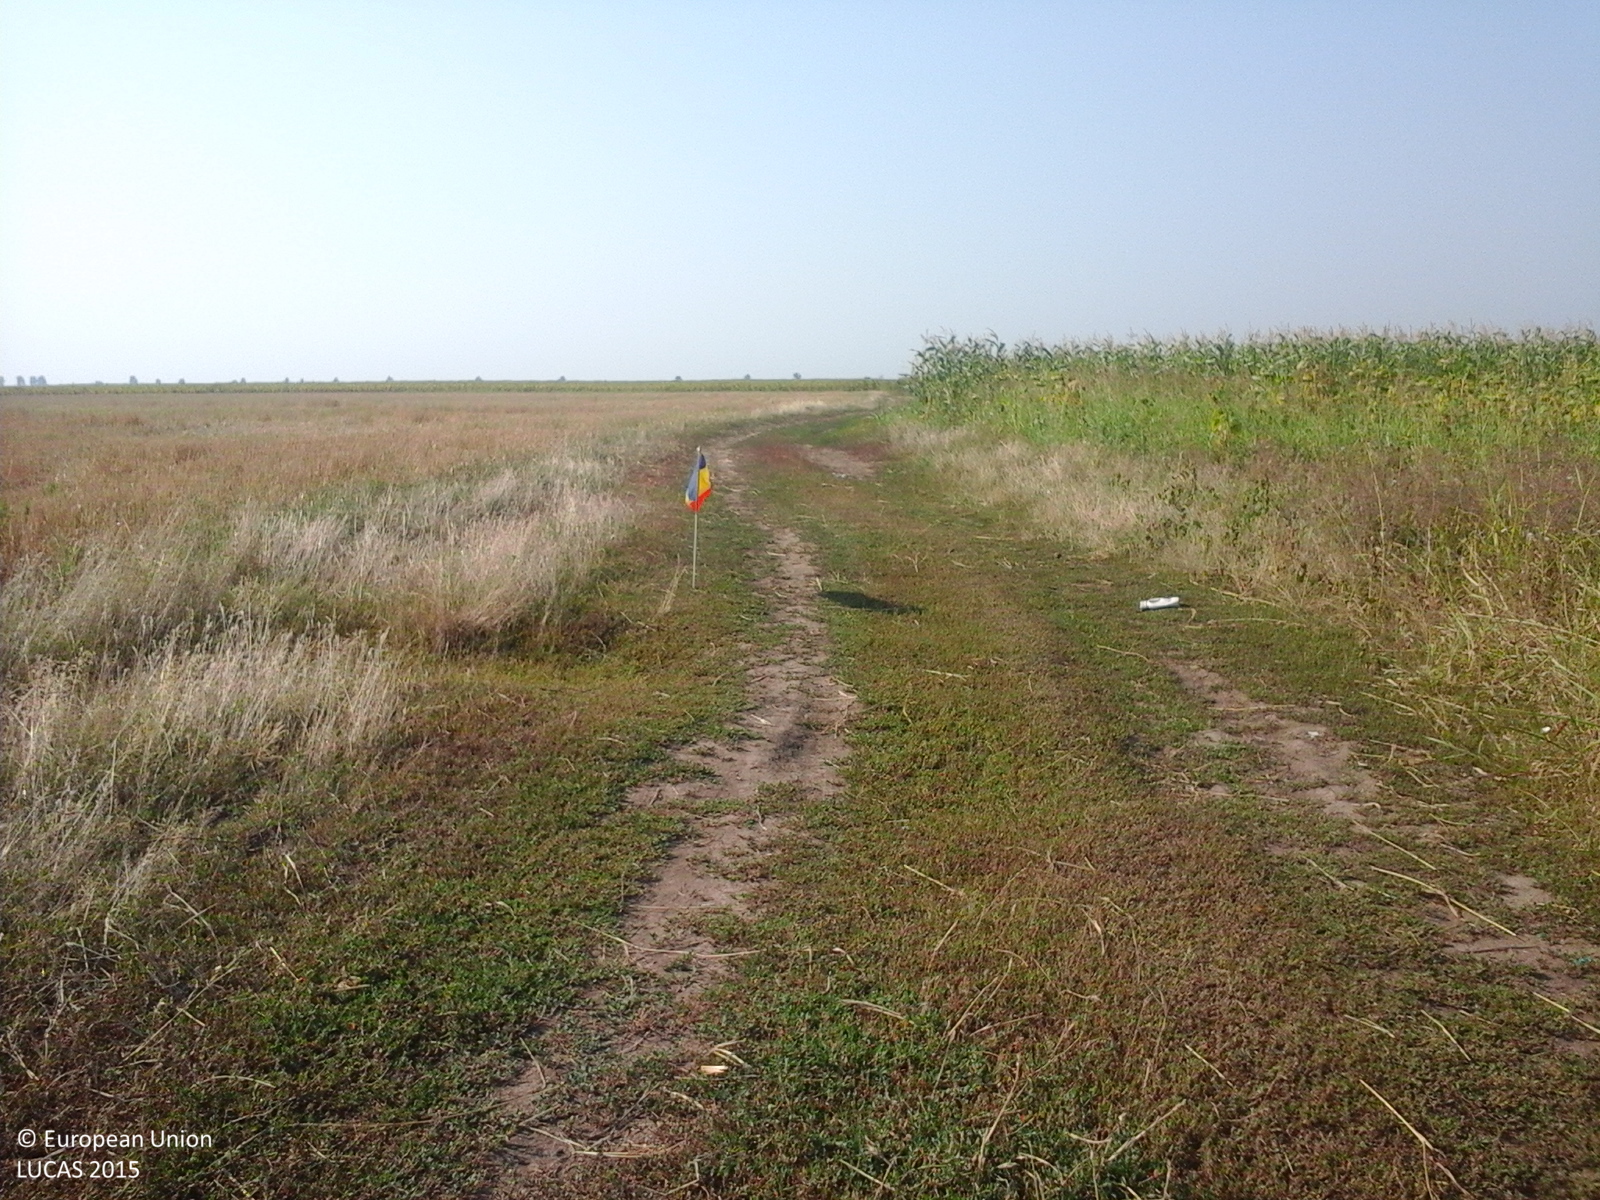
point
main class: Cropland
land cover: Common wheat
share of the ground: > 75 %
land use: Agriculture (excluding fallow land and kitchen gardens)
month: August
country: RO
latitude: 45.7119
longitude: 27.5637
